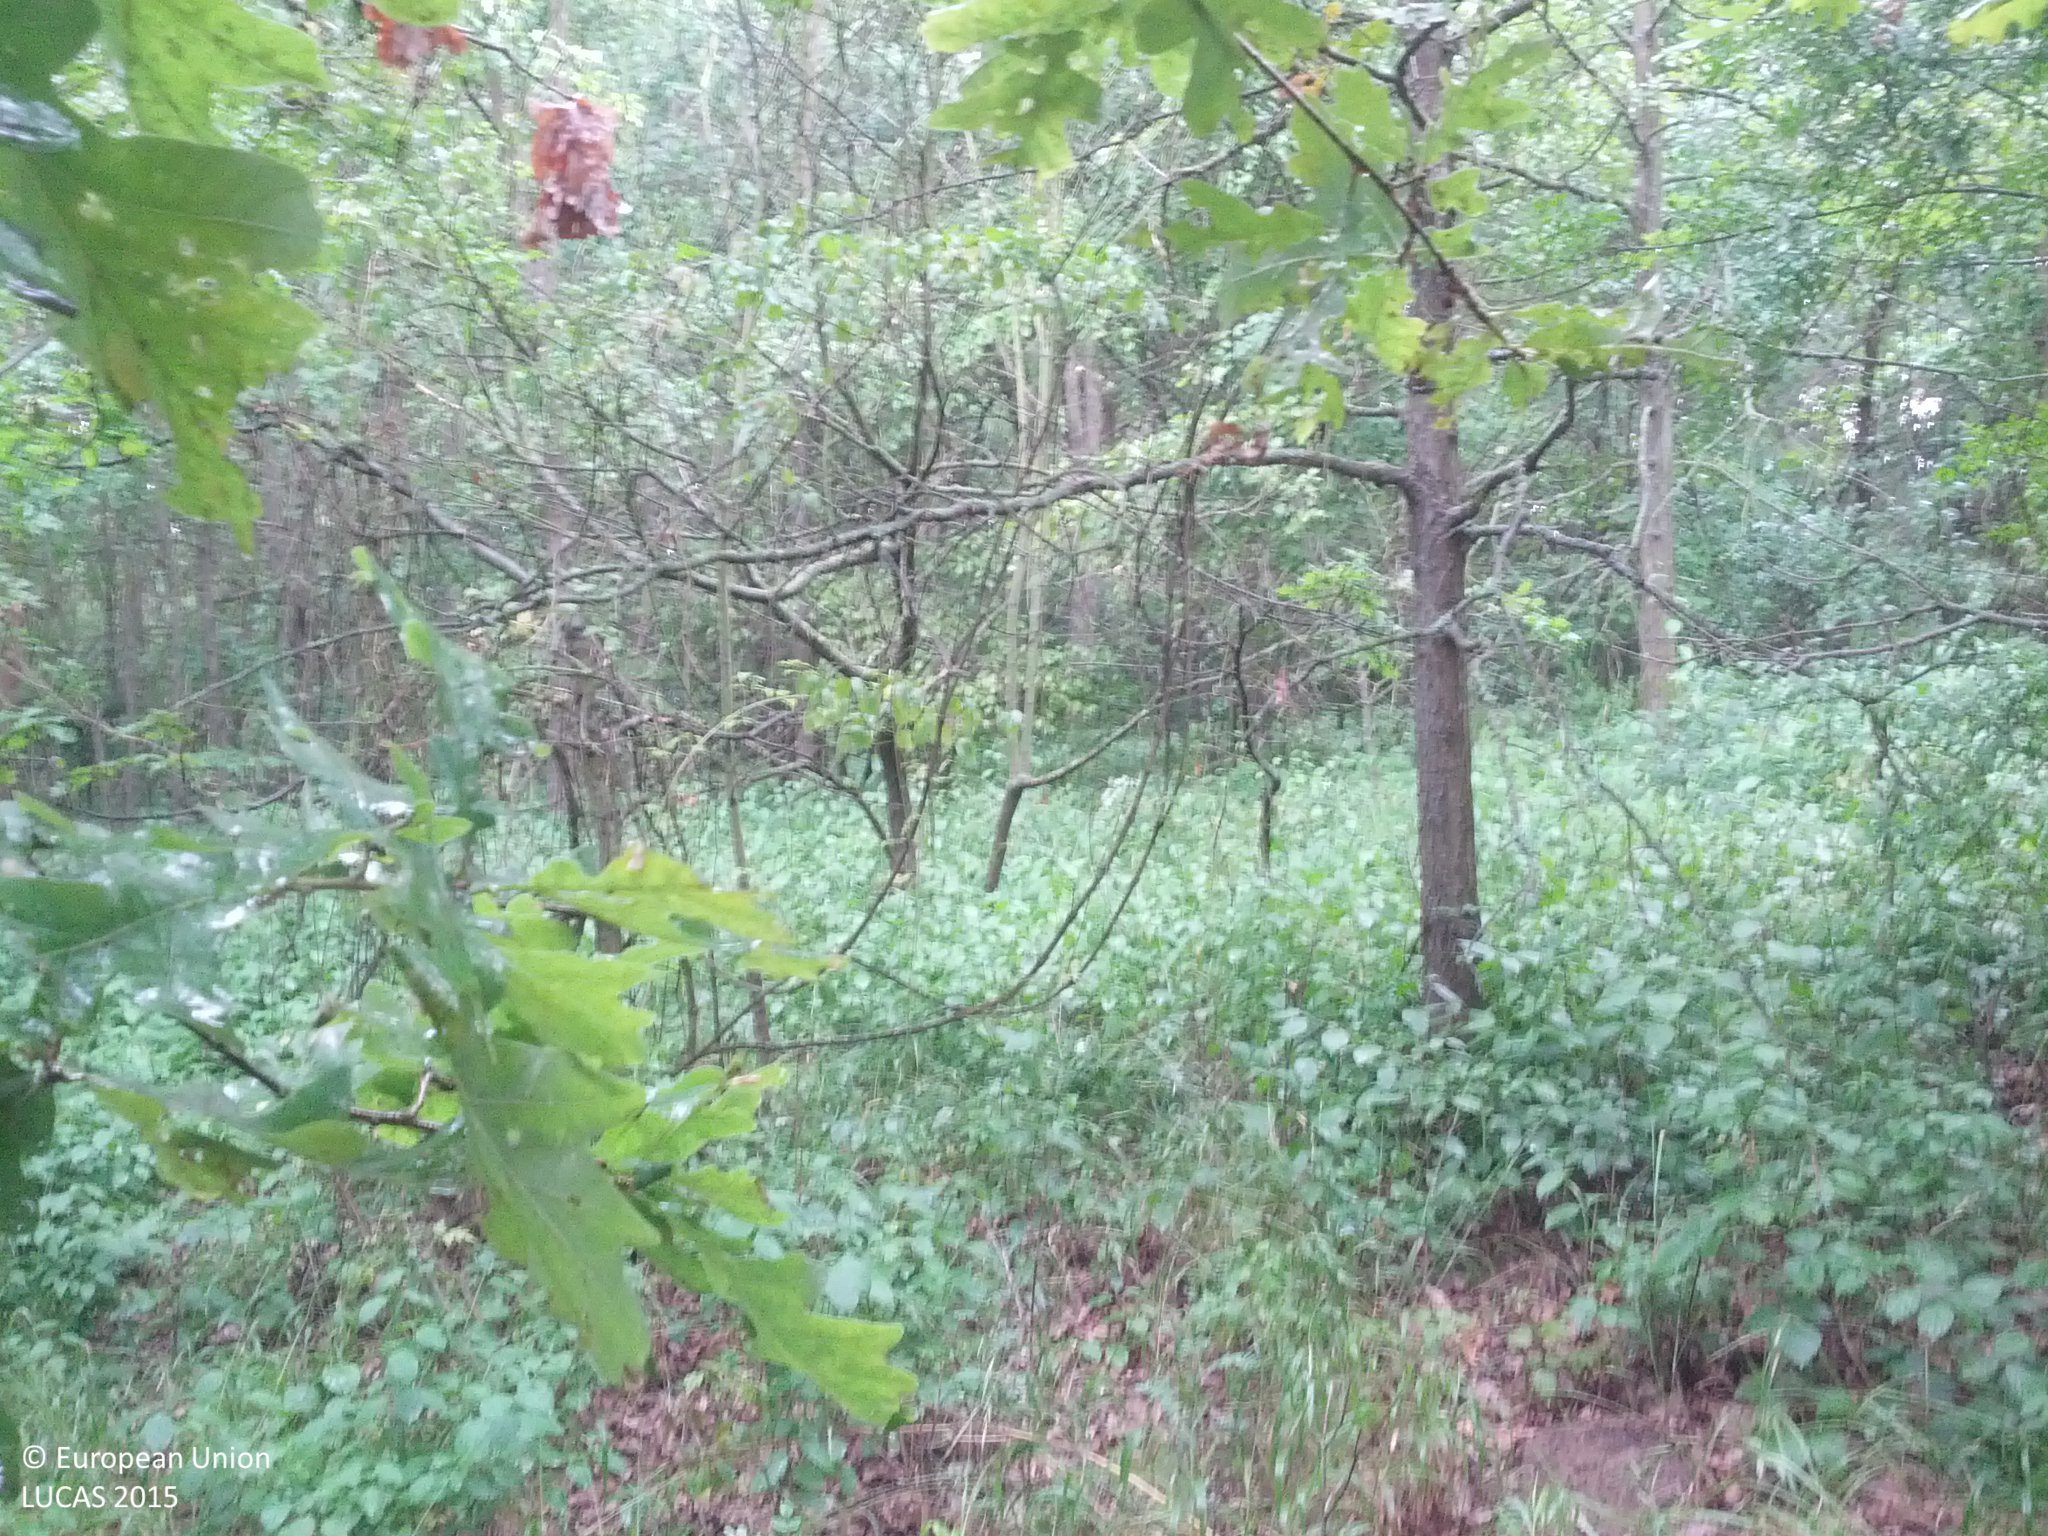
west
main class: Woodland
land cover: Pine dominated mixed woodland
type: hemiboreal forest and nemoral coniferous forest and mixed broadleaved-coniferous forest
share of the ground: > 75 %
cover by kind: coniferous forest trees 65 %, broadleaved forest trees 25 %, herbaceous plants 10 %
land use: Forestry
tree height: > 5 m
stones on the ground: < 10 %
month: July
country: AT
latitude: 48.5754
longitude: 16.1447
